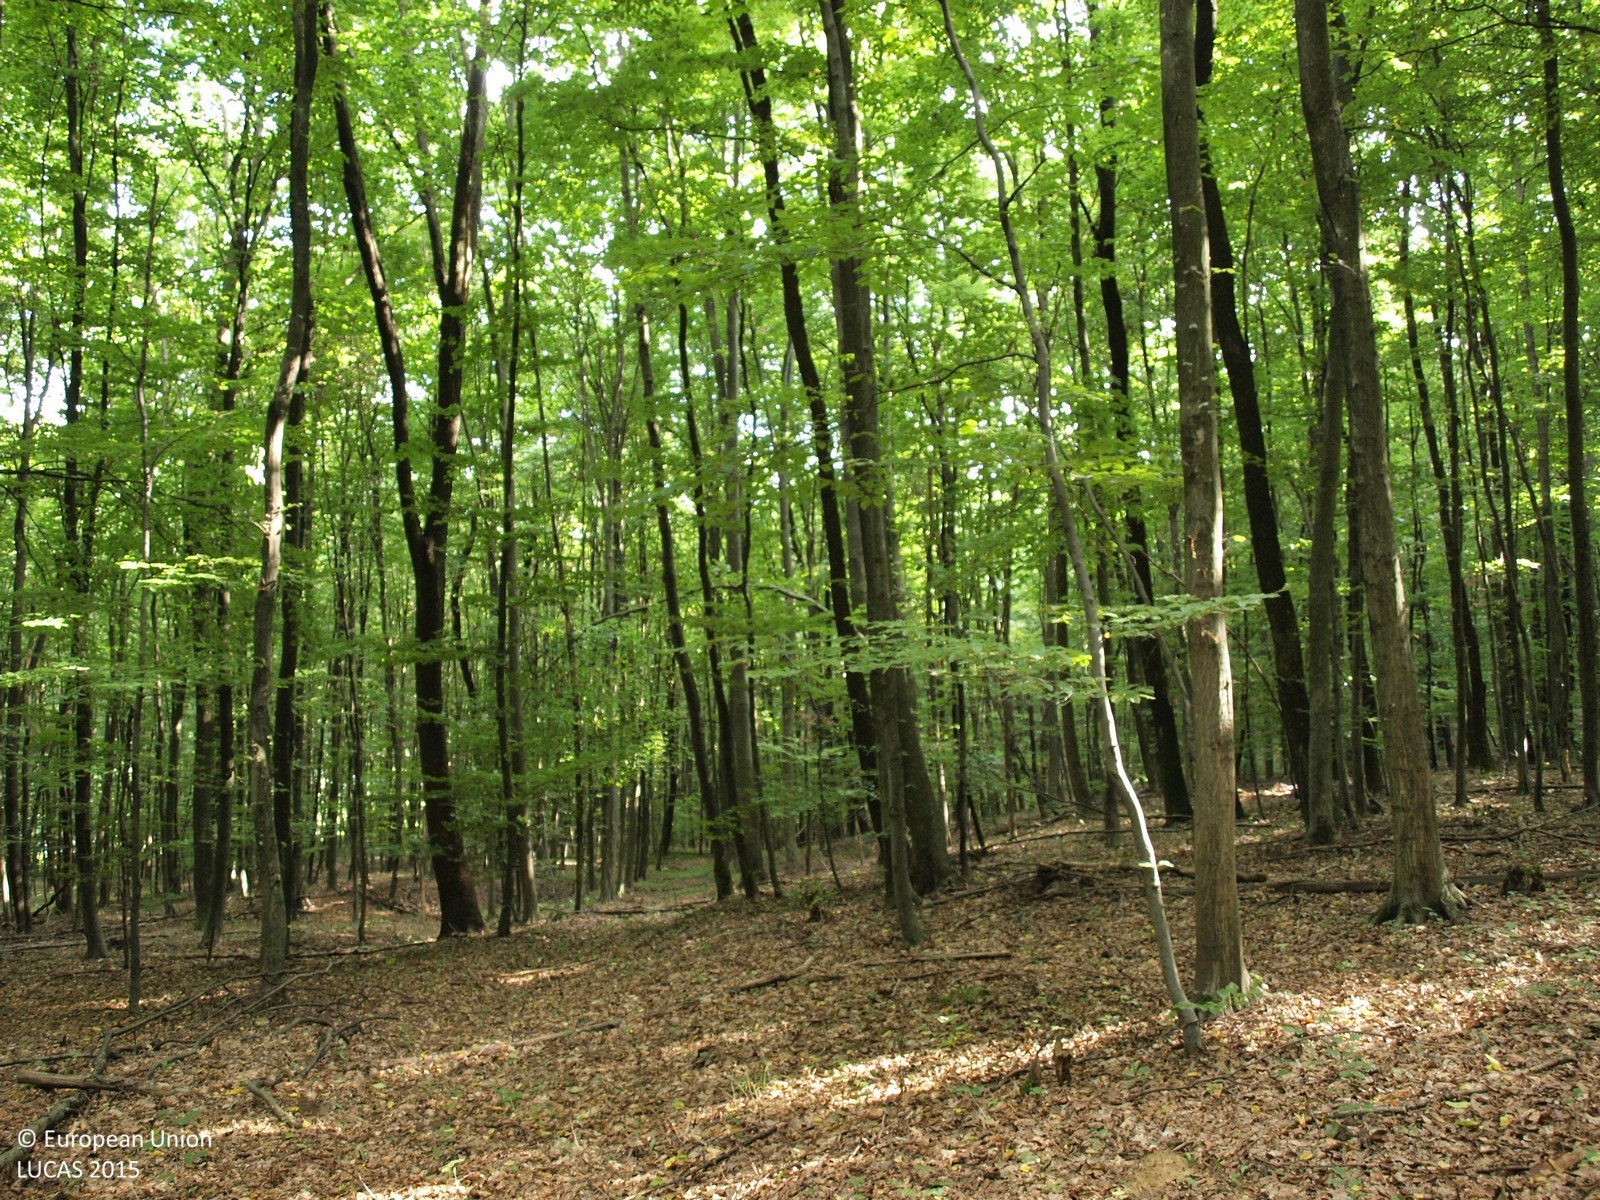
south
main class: Woodland
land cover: Broadleaved woodland
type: mesophytic deciduous forest
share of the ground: > 75 %
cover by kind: broadleaved forest trees 100 %
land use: Forestry
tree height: > 5 m
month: August
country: HR
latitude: 46.0371
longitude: 16.6287
